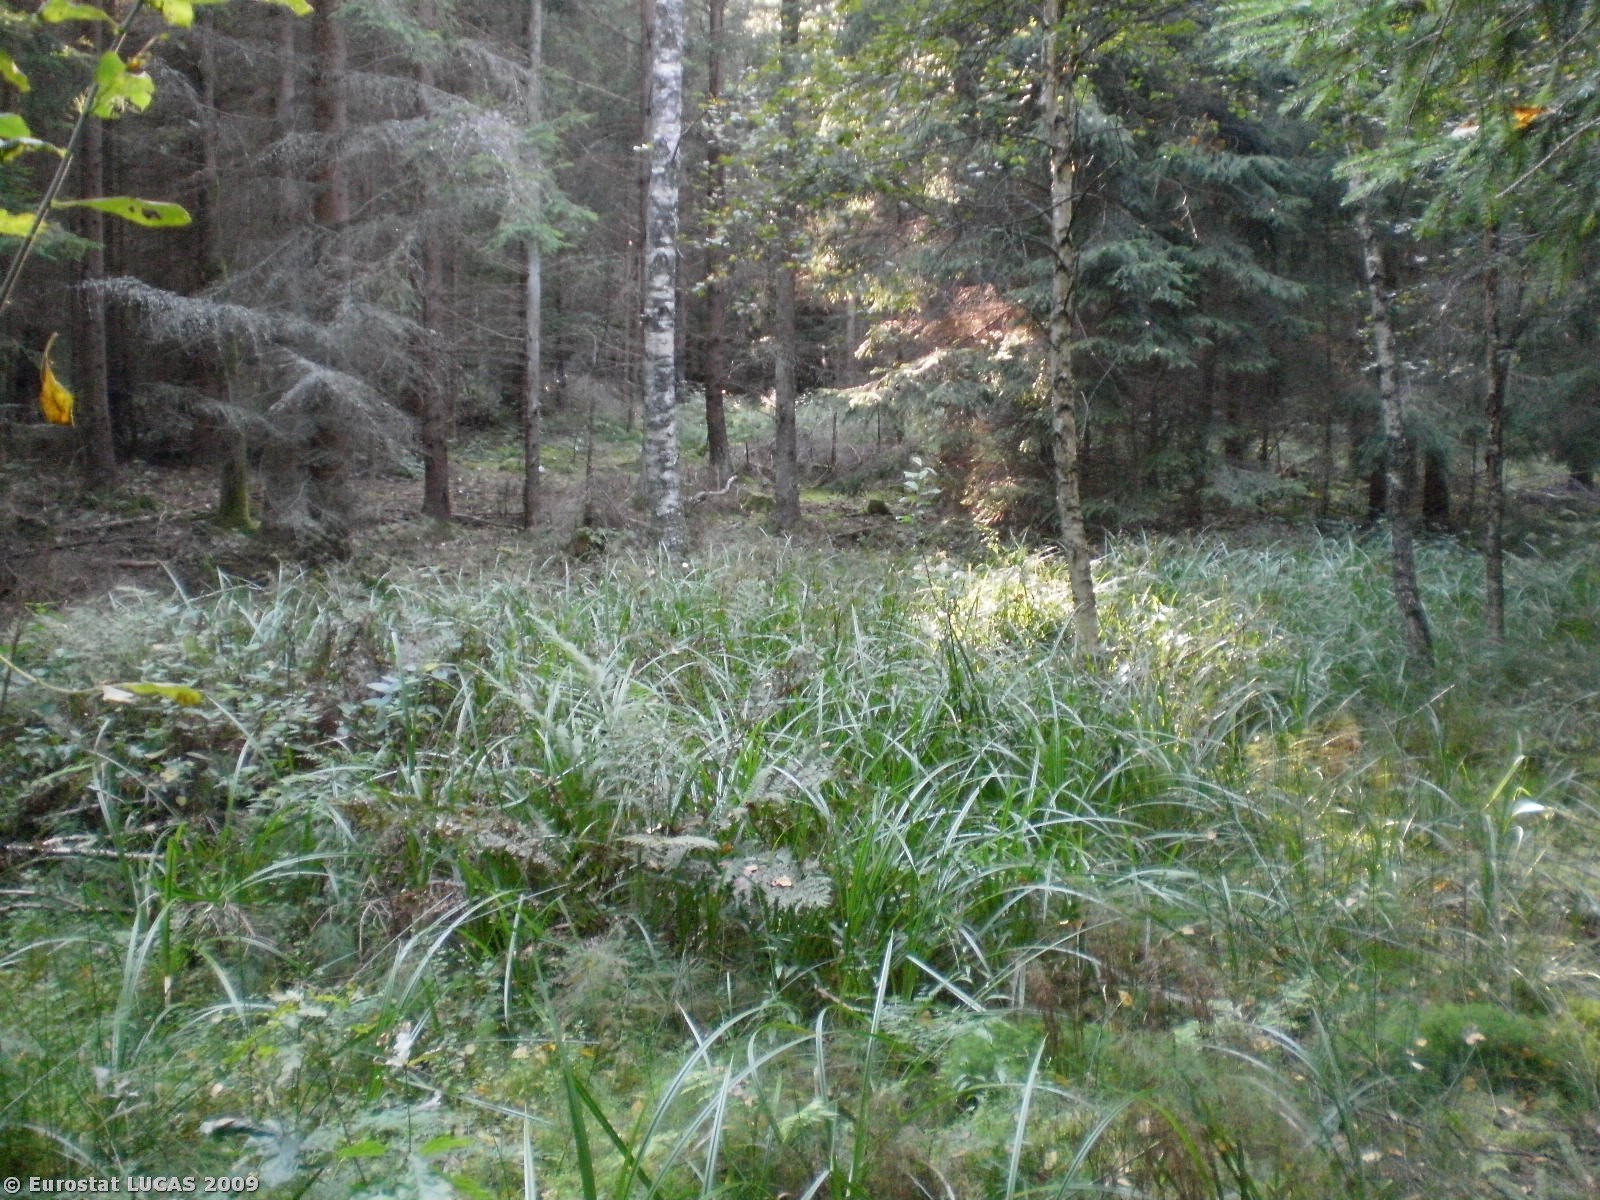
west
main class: Woodland
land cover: Mixed woodland
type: hemiboreal forest and nemoral coniferous forest and mixed broadleaved-coniferous forest
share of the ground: 50 - 75 %
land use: Forestry
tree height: > 5 m
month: August
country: PL
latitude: 54.1705
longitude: 22.1449
